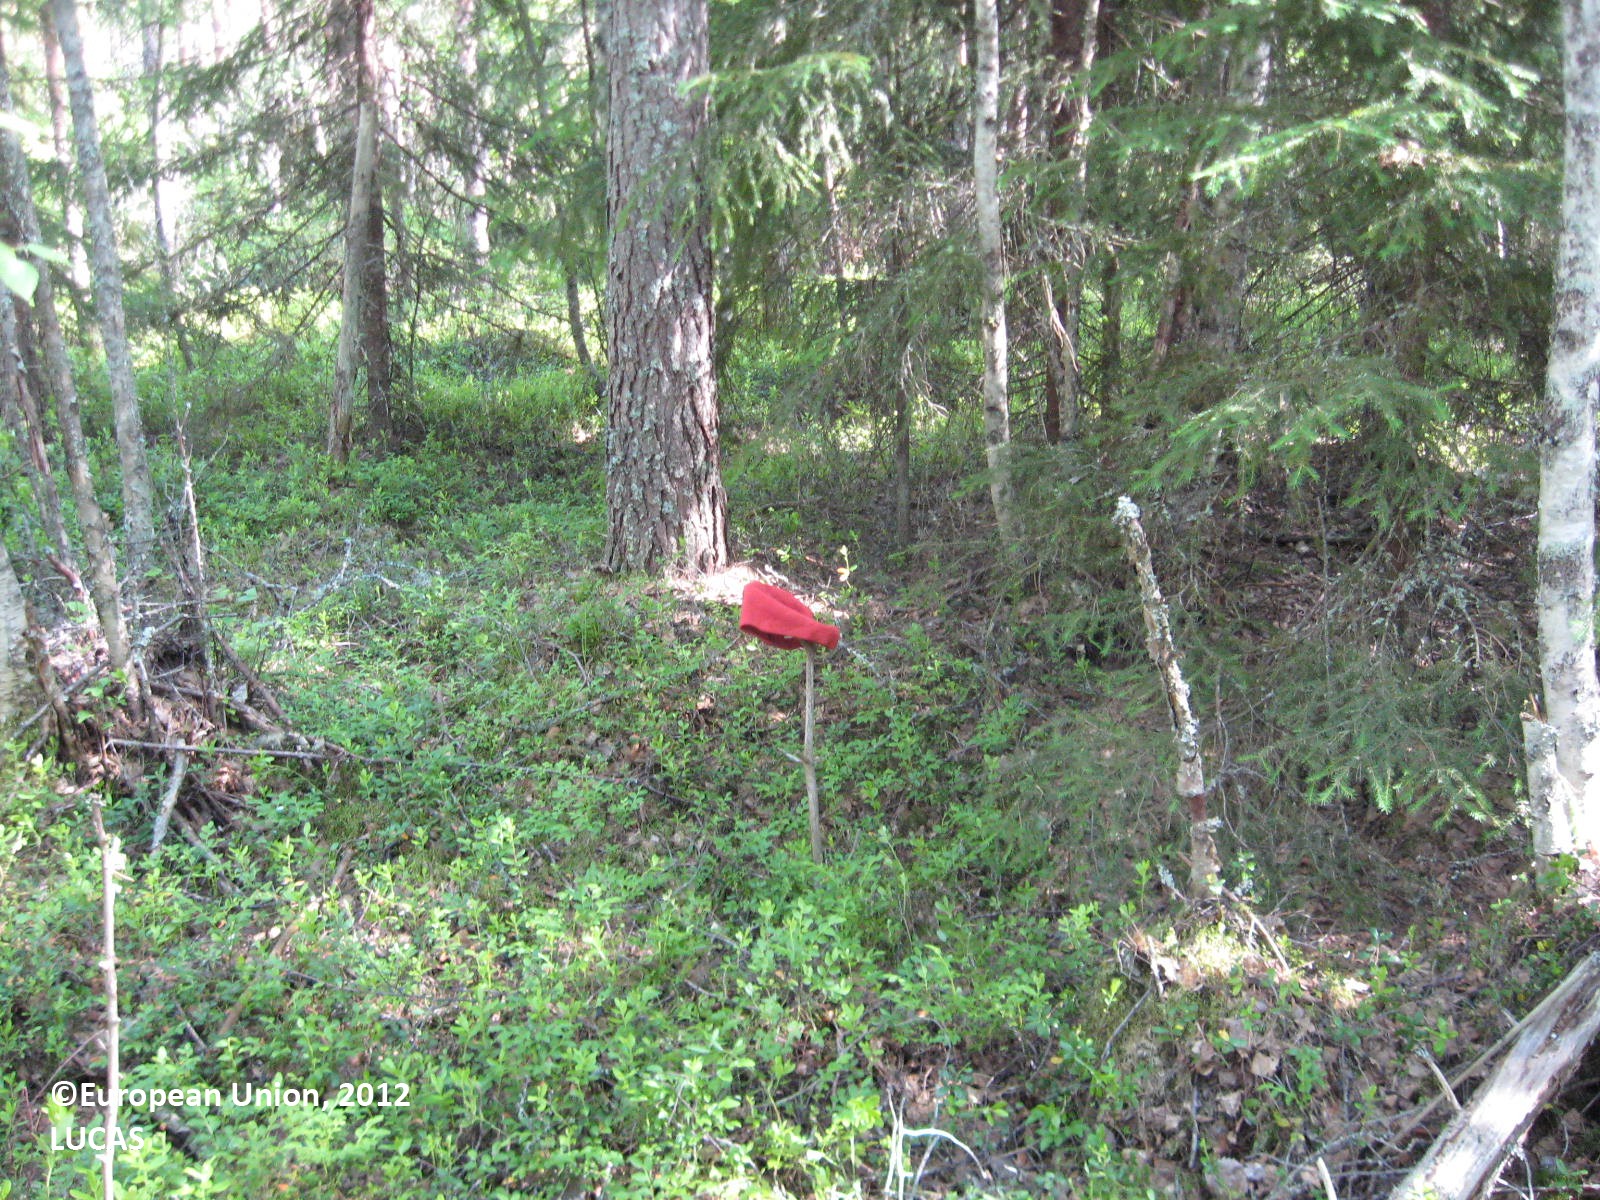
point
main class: Woodland
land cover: Other mixed woodland
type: boreal forest
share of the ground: > 75 %
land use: Forestry
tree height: > 5 m
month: June
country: FI
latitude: 62.6779
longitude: 21.7821
